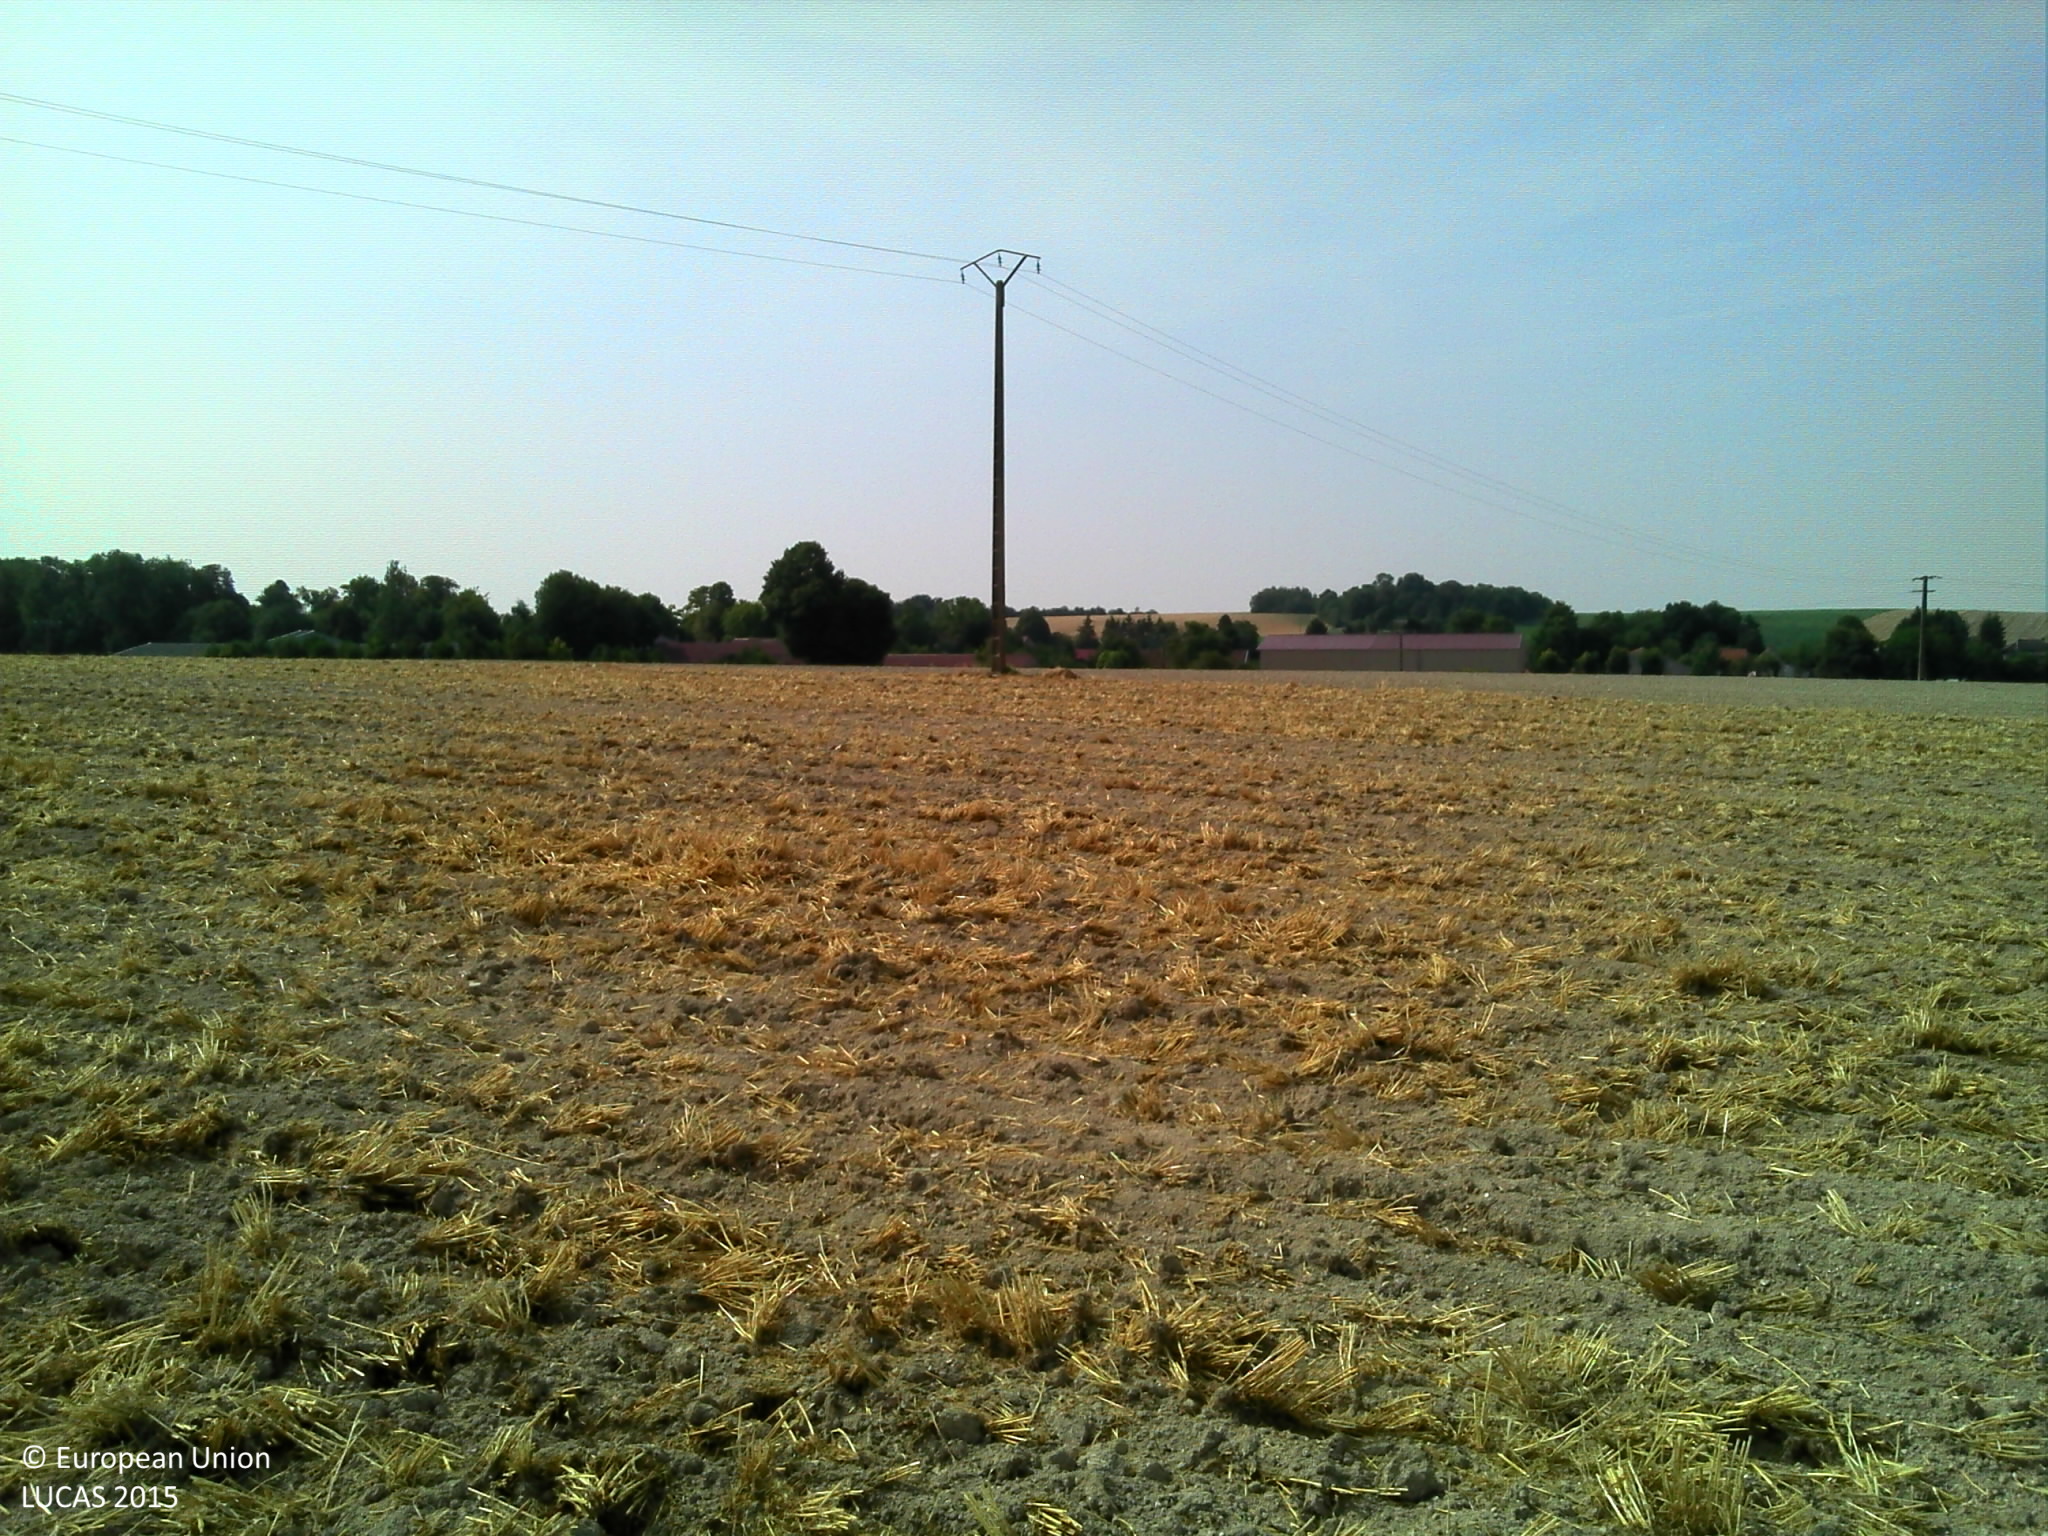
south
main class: Cropland
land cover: Common wheat
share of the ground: > 75 %
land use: Agriculture (excluding fallow land and kitchen gardens)
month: August
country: FR
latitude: 48.7170
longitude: 4.1378
